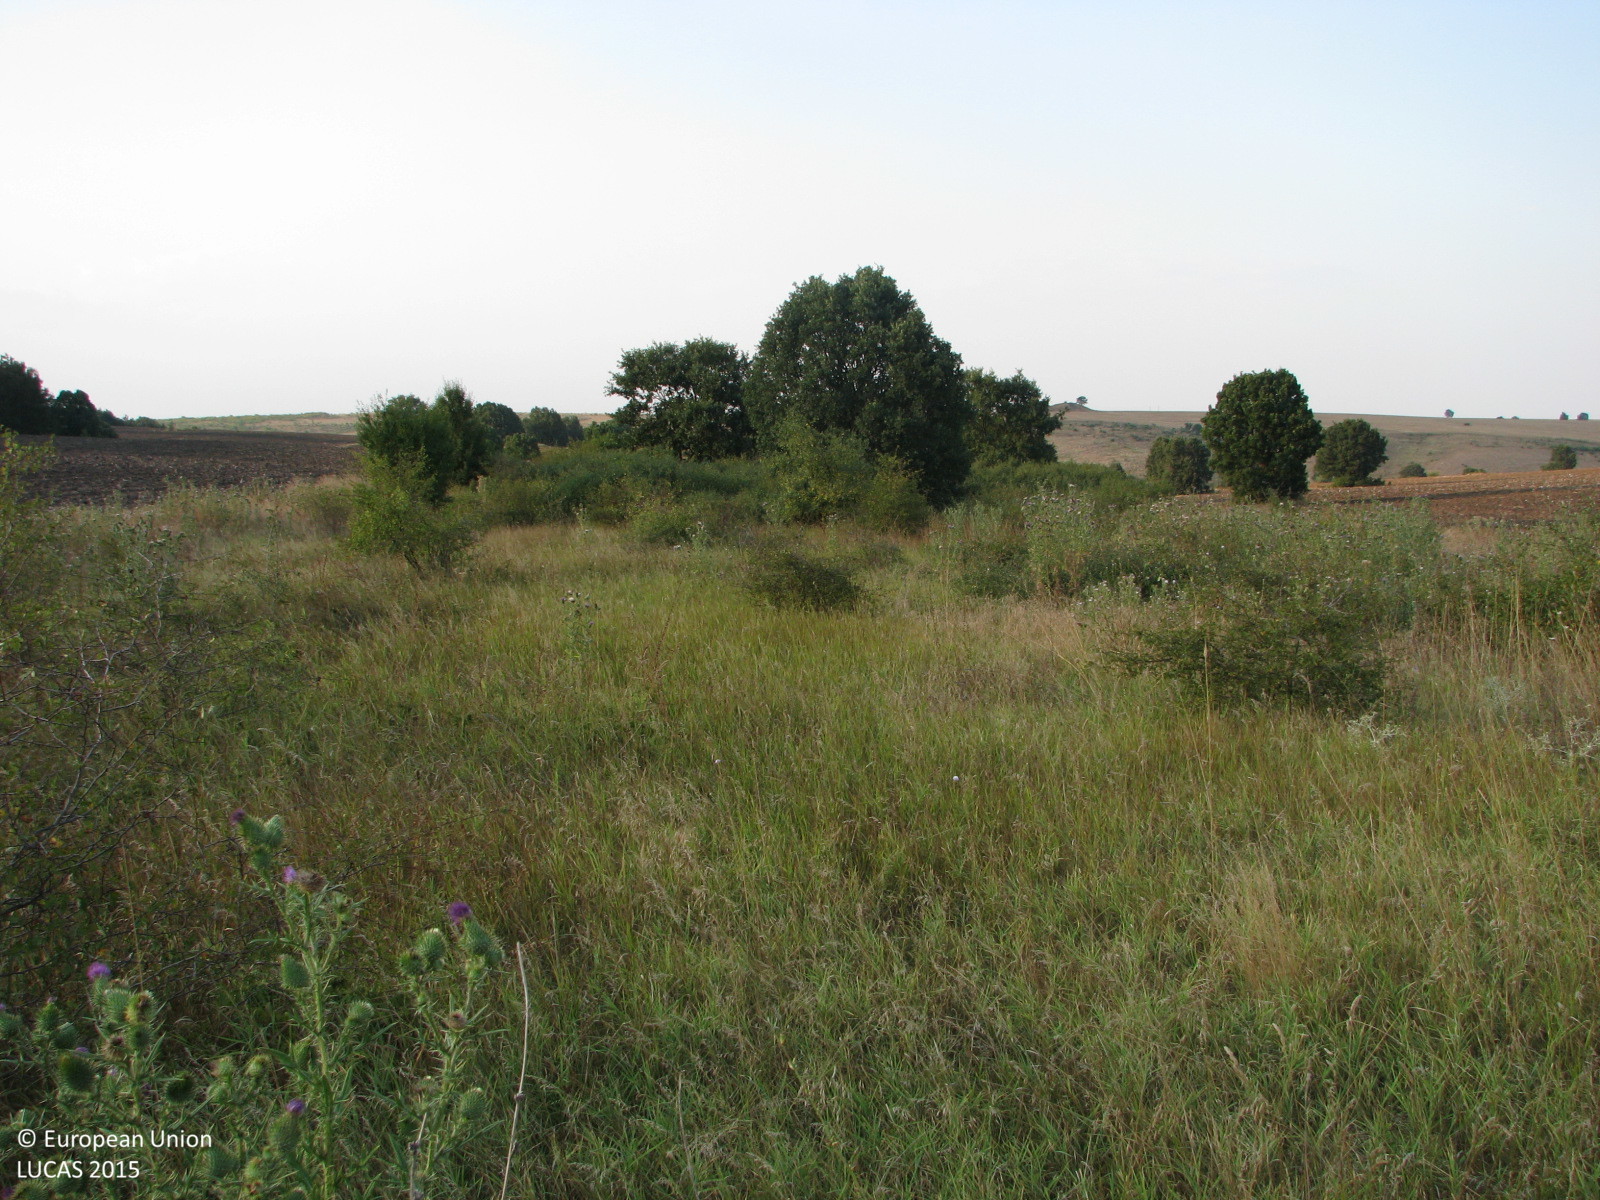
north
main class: Grassland
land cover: Grassland with sparse tree/shrub cover
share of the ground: > 75 %
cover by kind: herbaceous plants 85 %, shrubs 10 %, broadleaved forest trees 5 %
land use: Abandoned areas
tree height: < 5 m
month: August
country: BG
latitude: 42.1497
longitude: 26.8565
